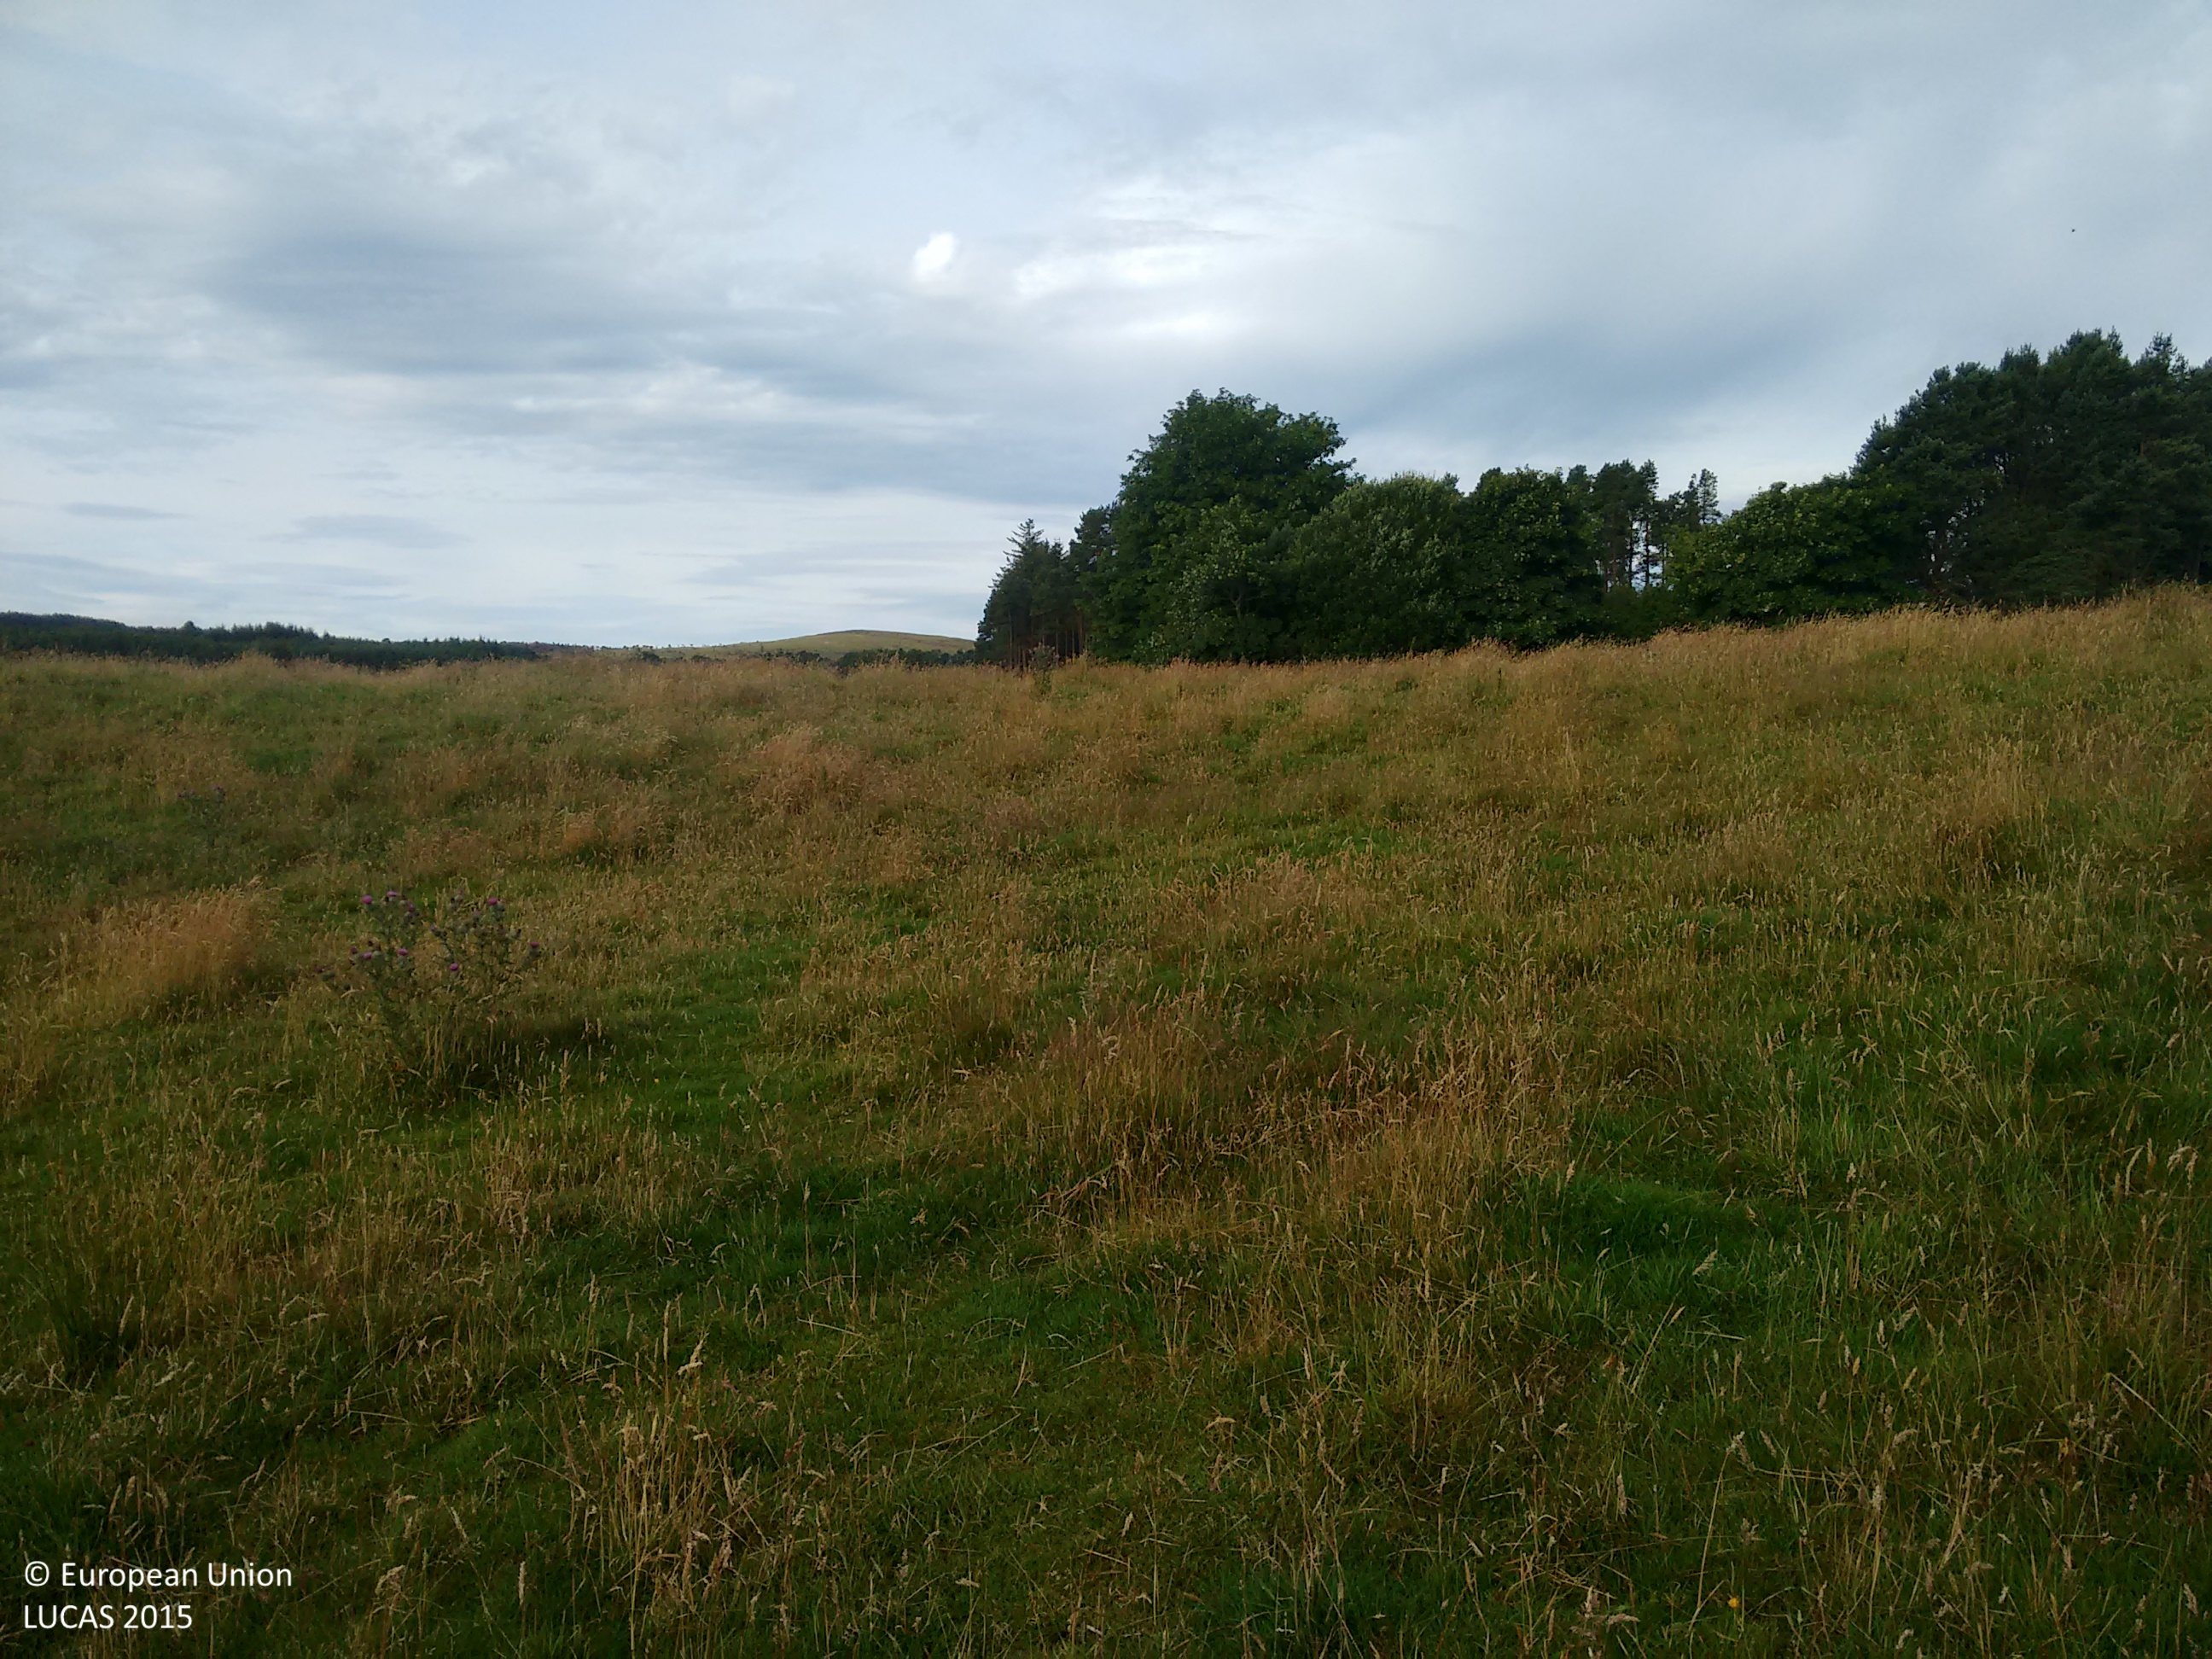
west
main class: Grassland
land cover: Grassland without tree/shrub cover
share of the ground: > 75 %
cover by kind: herbaceous plants 100 %
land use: Agriculture (excluding fallow land and kitchen gardens)
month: August
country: GB
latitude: 57.9308
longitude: -4.0786
